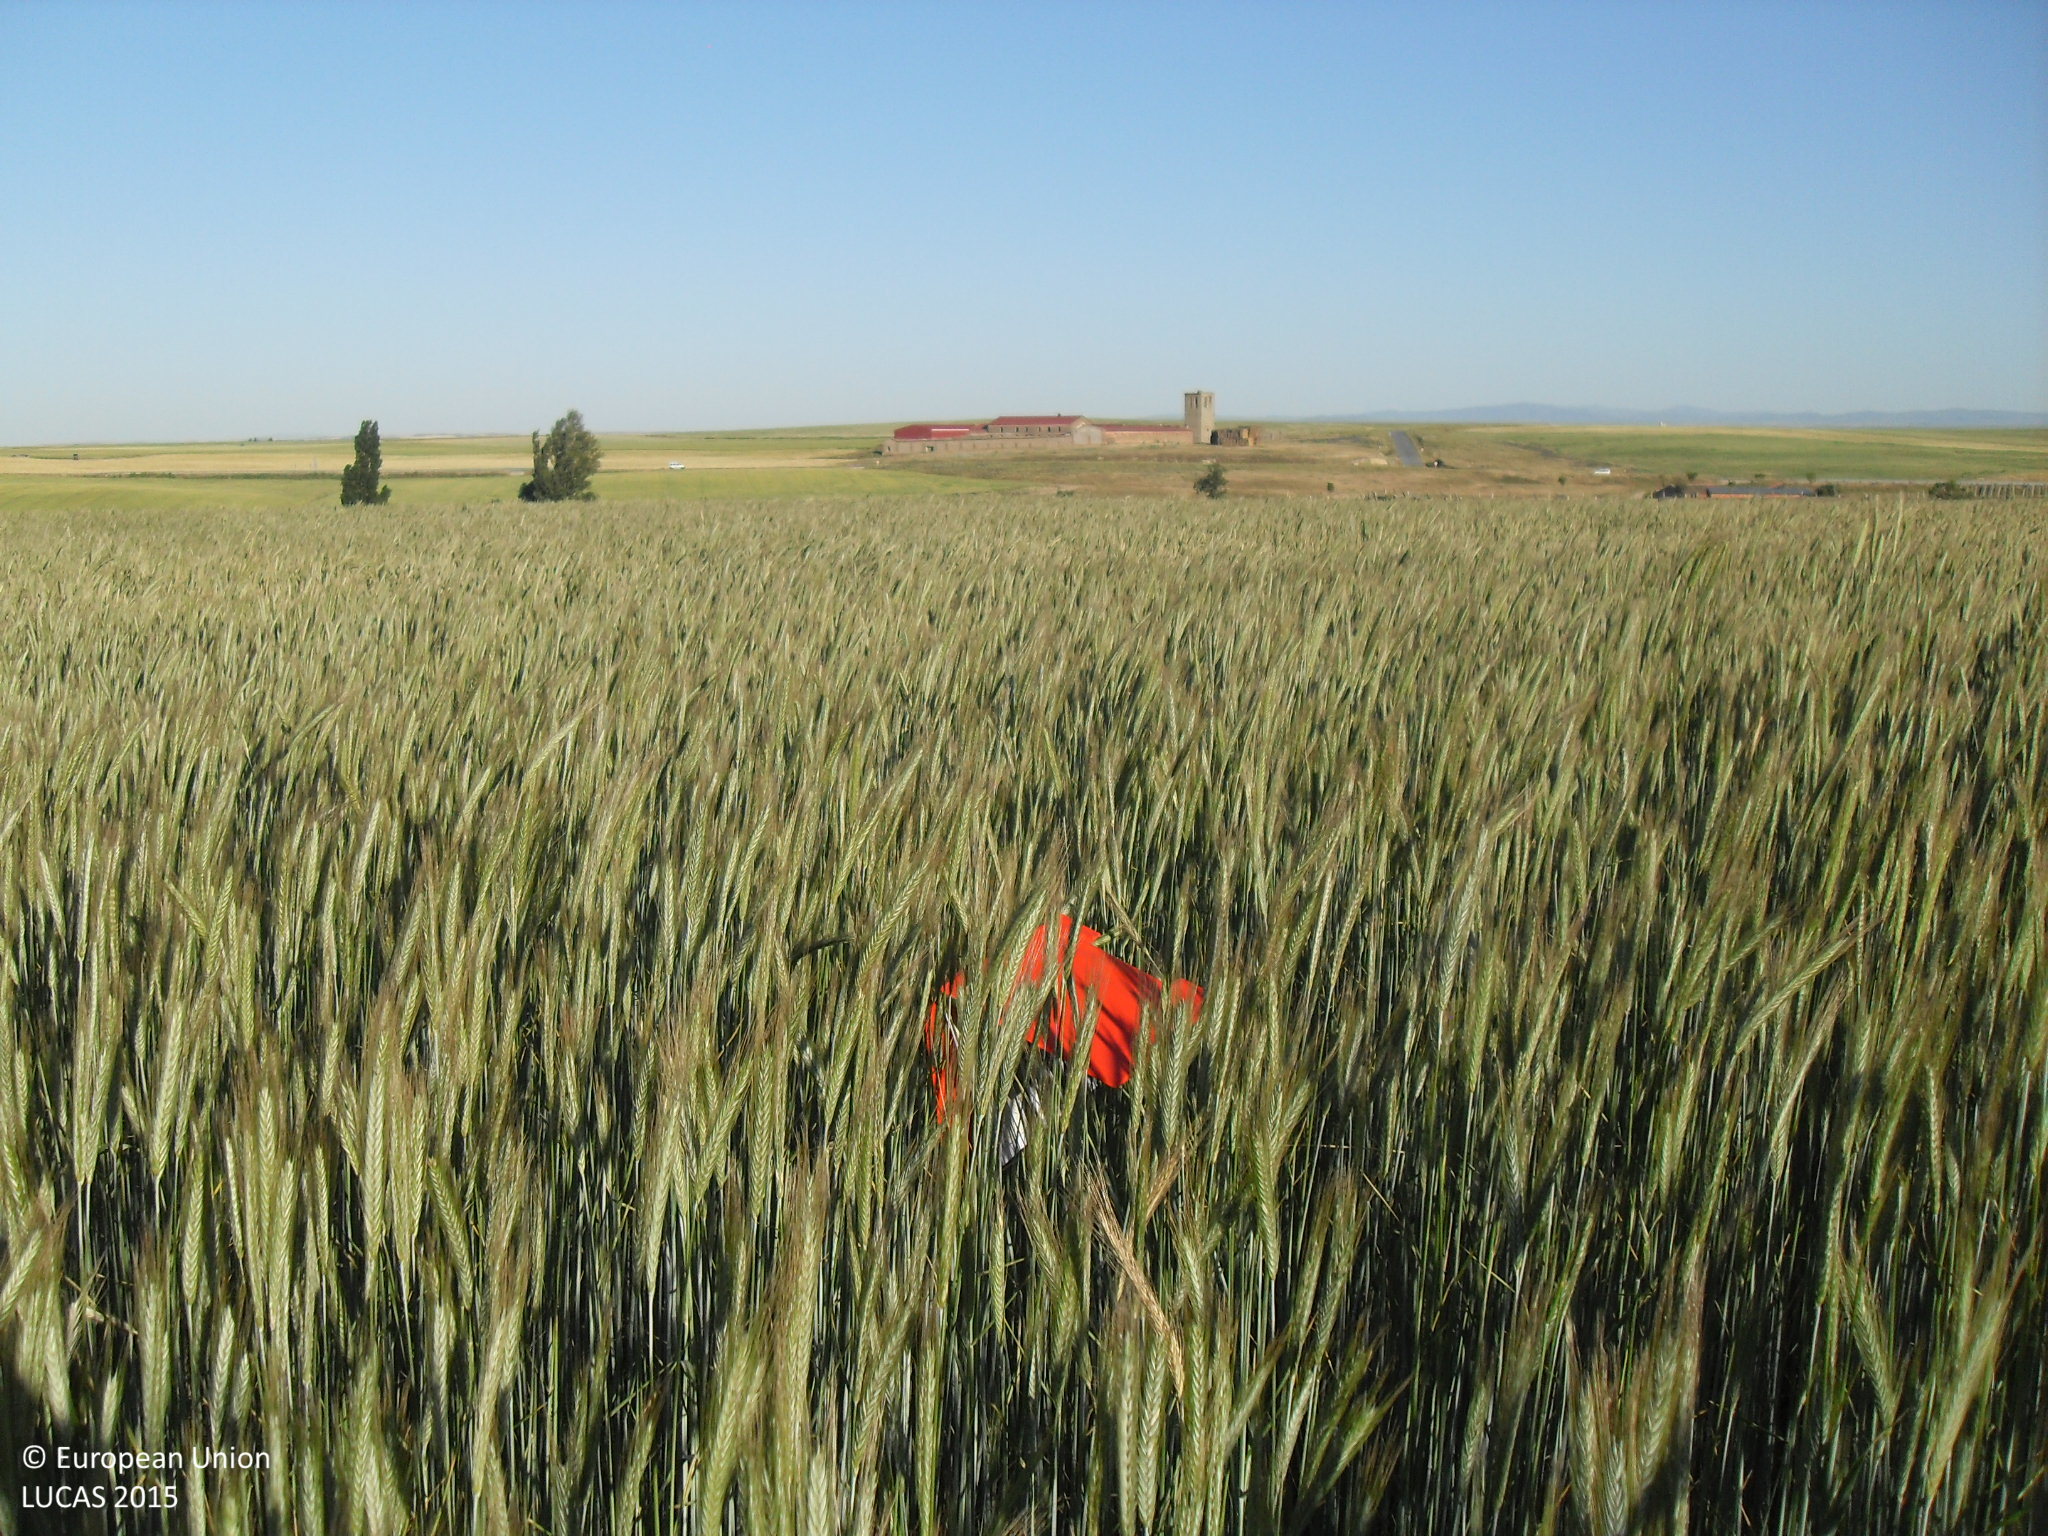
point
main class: Cropland
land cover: Rye
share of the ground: > 75 %
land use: Agriculture (excluding fallow land and kitchen gardens)
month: May
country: ES
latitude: 41.0239
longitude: -5.3059
